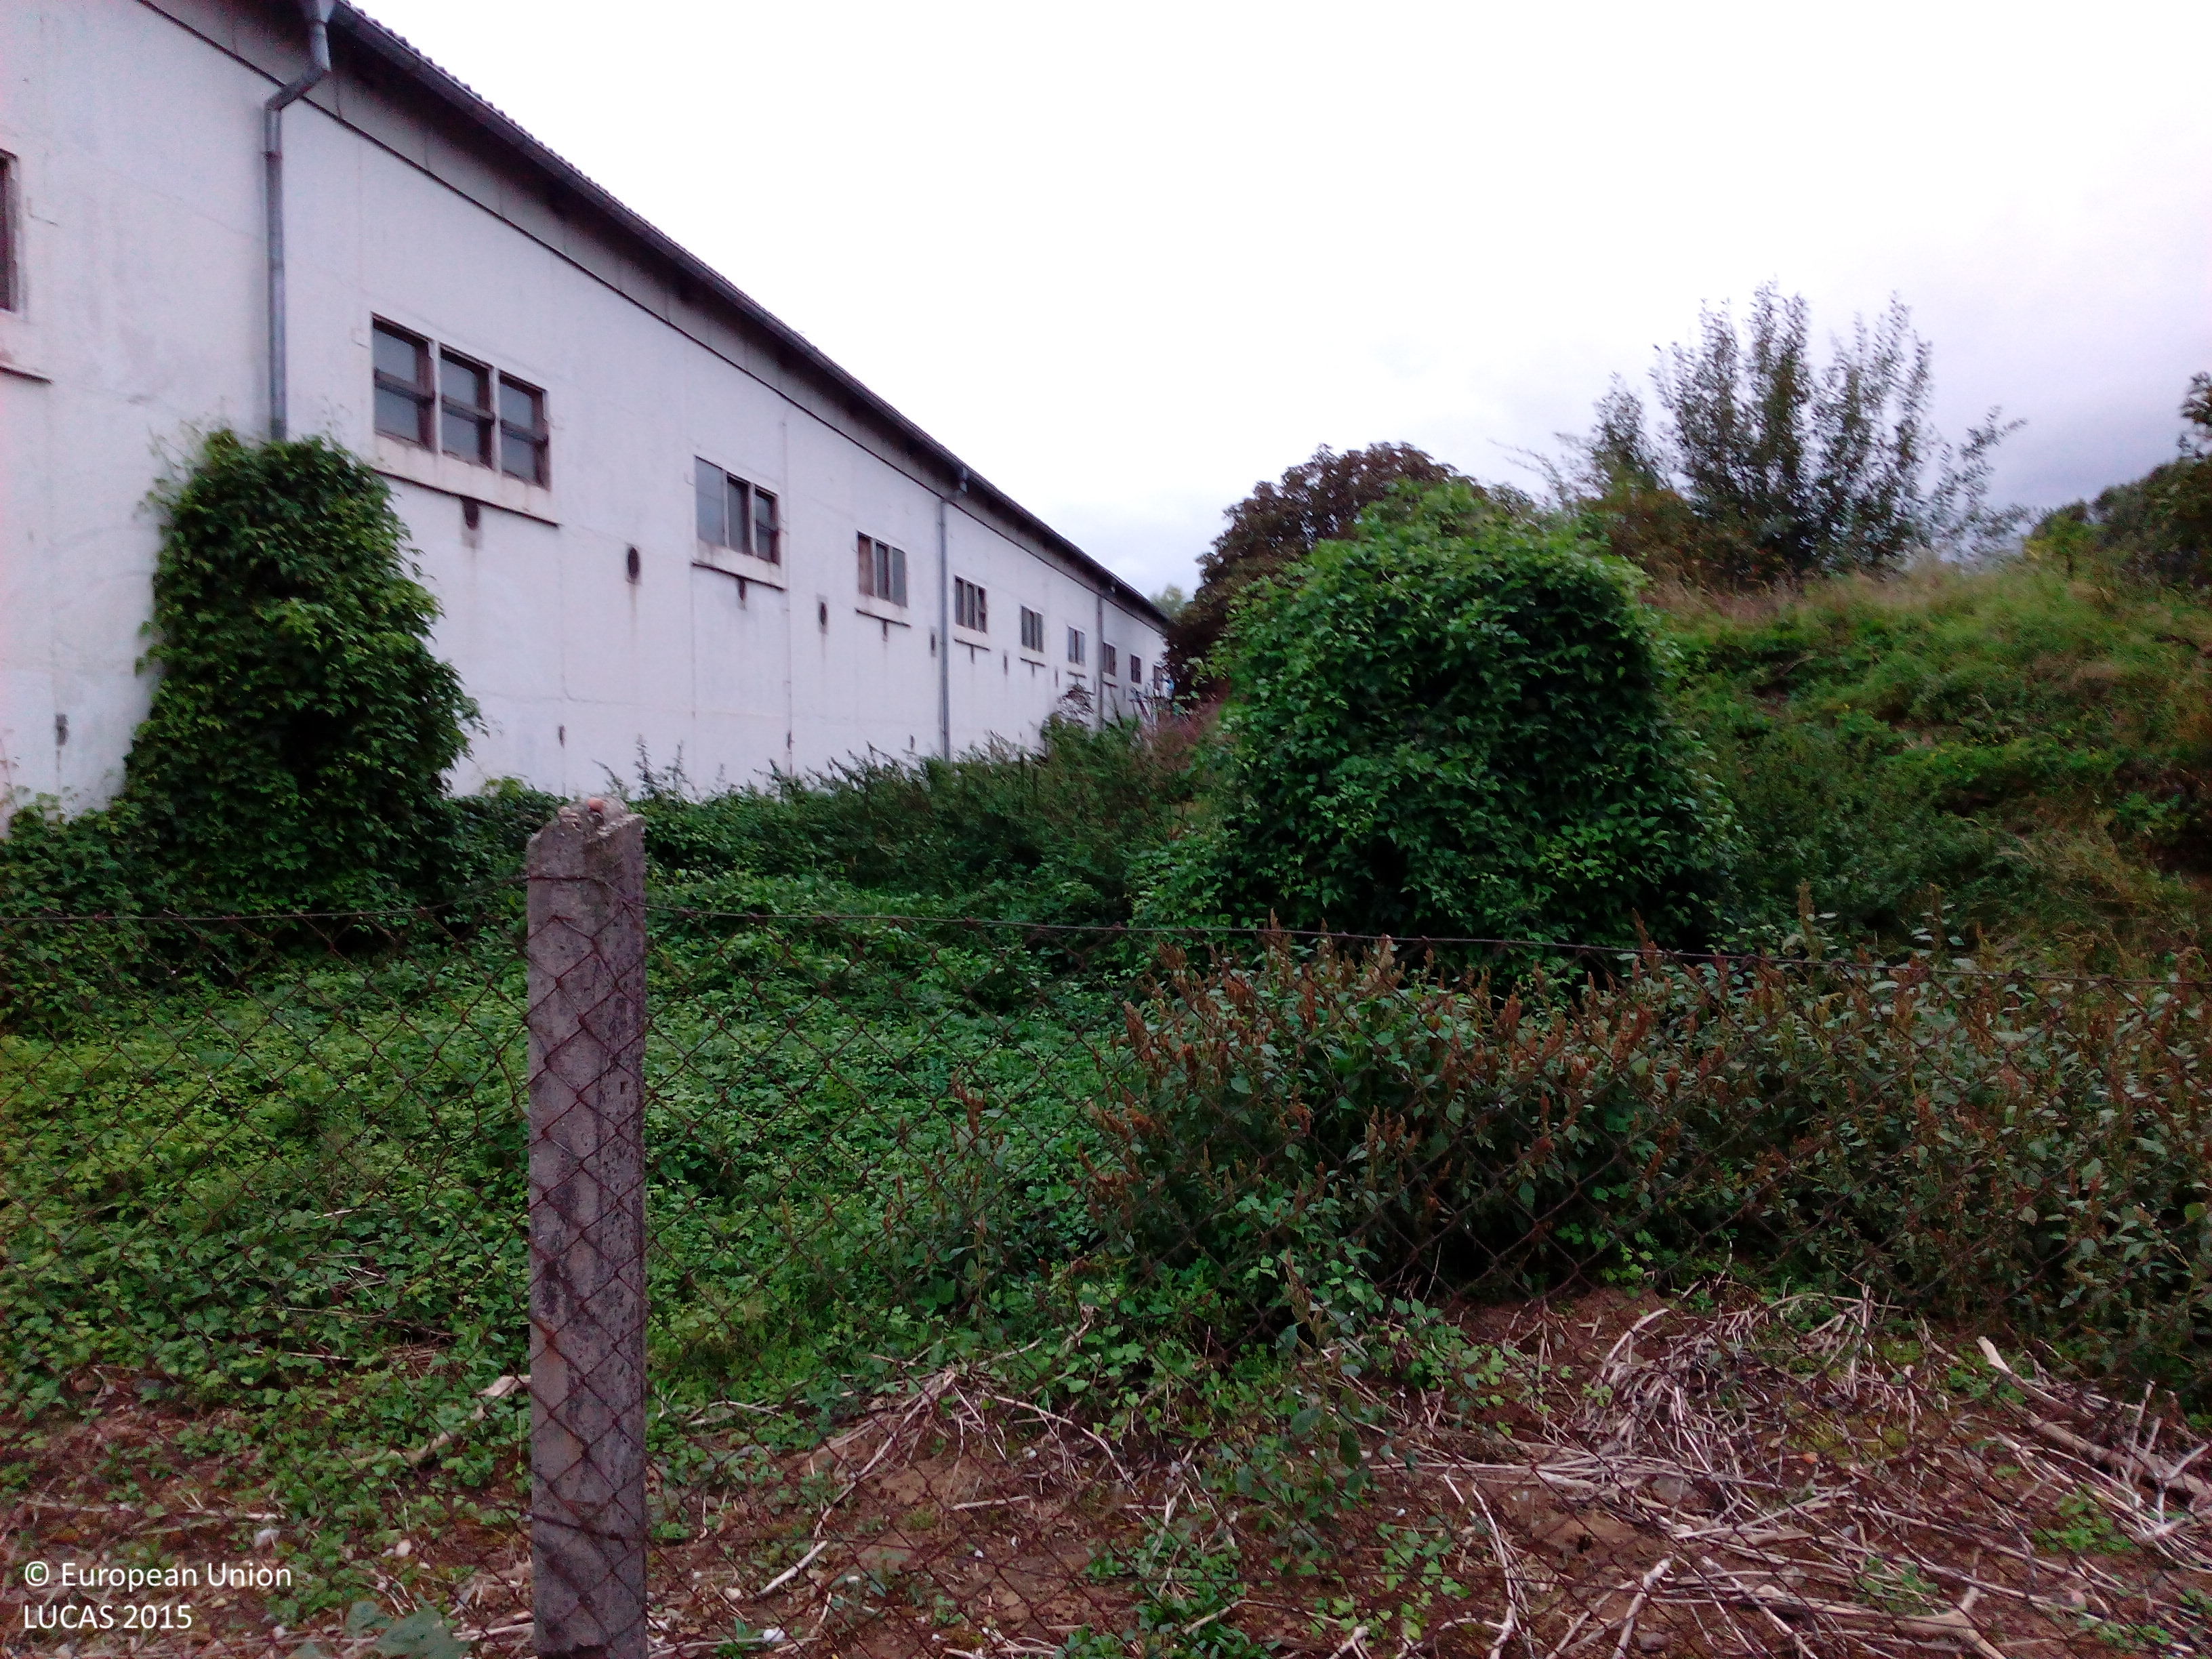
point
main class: Shrubland
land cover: Shrubland without tree cover
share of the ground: > 75 %
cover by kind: shrubs 90 %, herbaceous plants 10 %
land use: Semi-natural and natural areas not in use
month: September
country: DE
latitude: 51.8158
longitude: 11.0296
